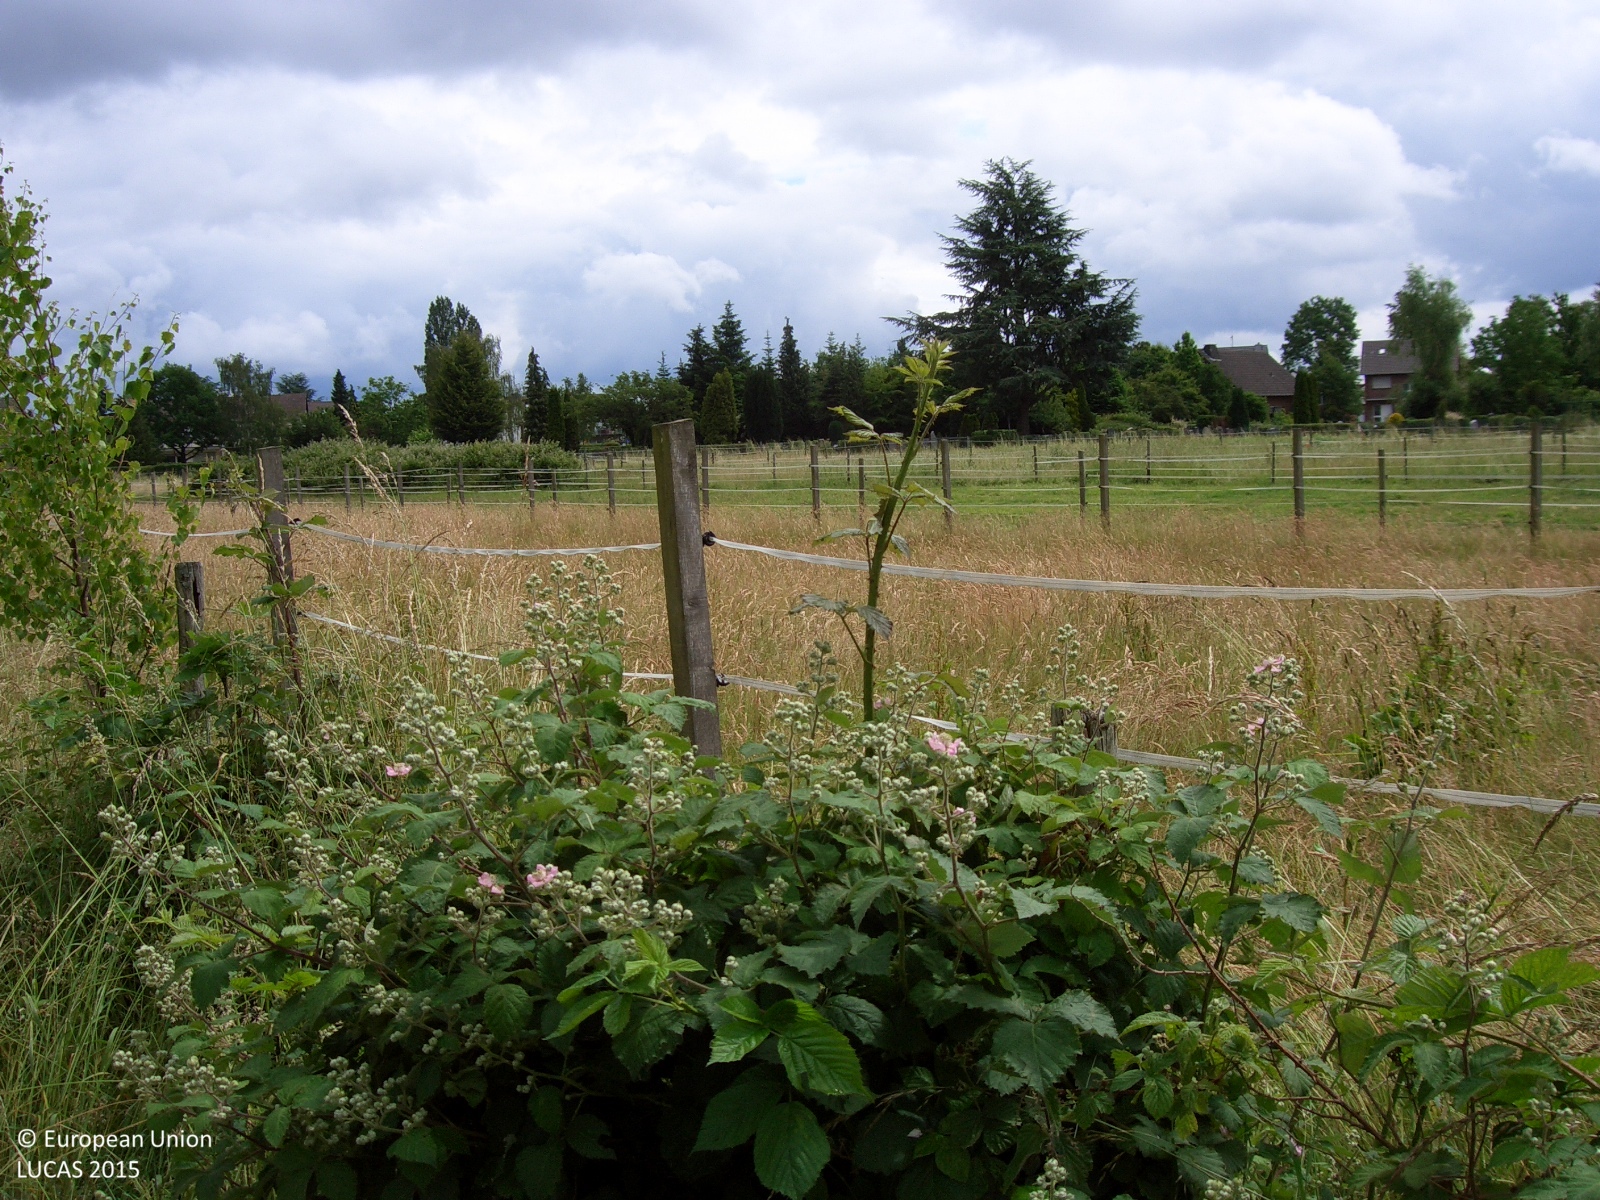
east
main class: Grassland
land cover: Grassland without tree/shrub cover
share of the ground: > 75 %
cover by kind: herbaceous plants 100 %
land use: Agriculture (excluding fallow land and kitchen gardens)
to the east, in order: Grassland without tree/shrub cover; Fences; Grassland without tree/shrub cover; Fences; Grass margins; Artificial constructions in urban areas
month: June
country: DE
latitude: 50.7209
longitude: 7.0113
